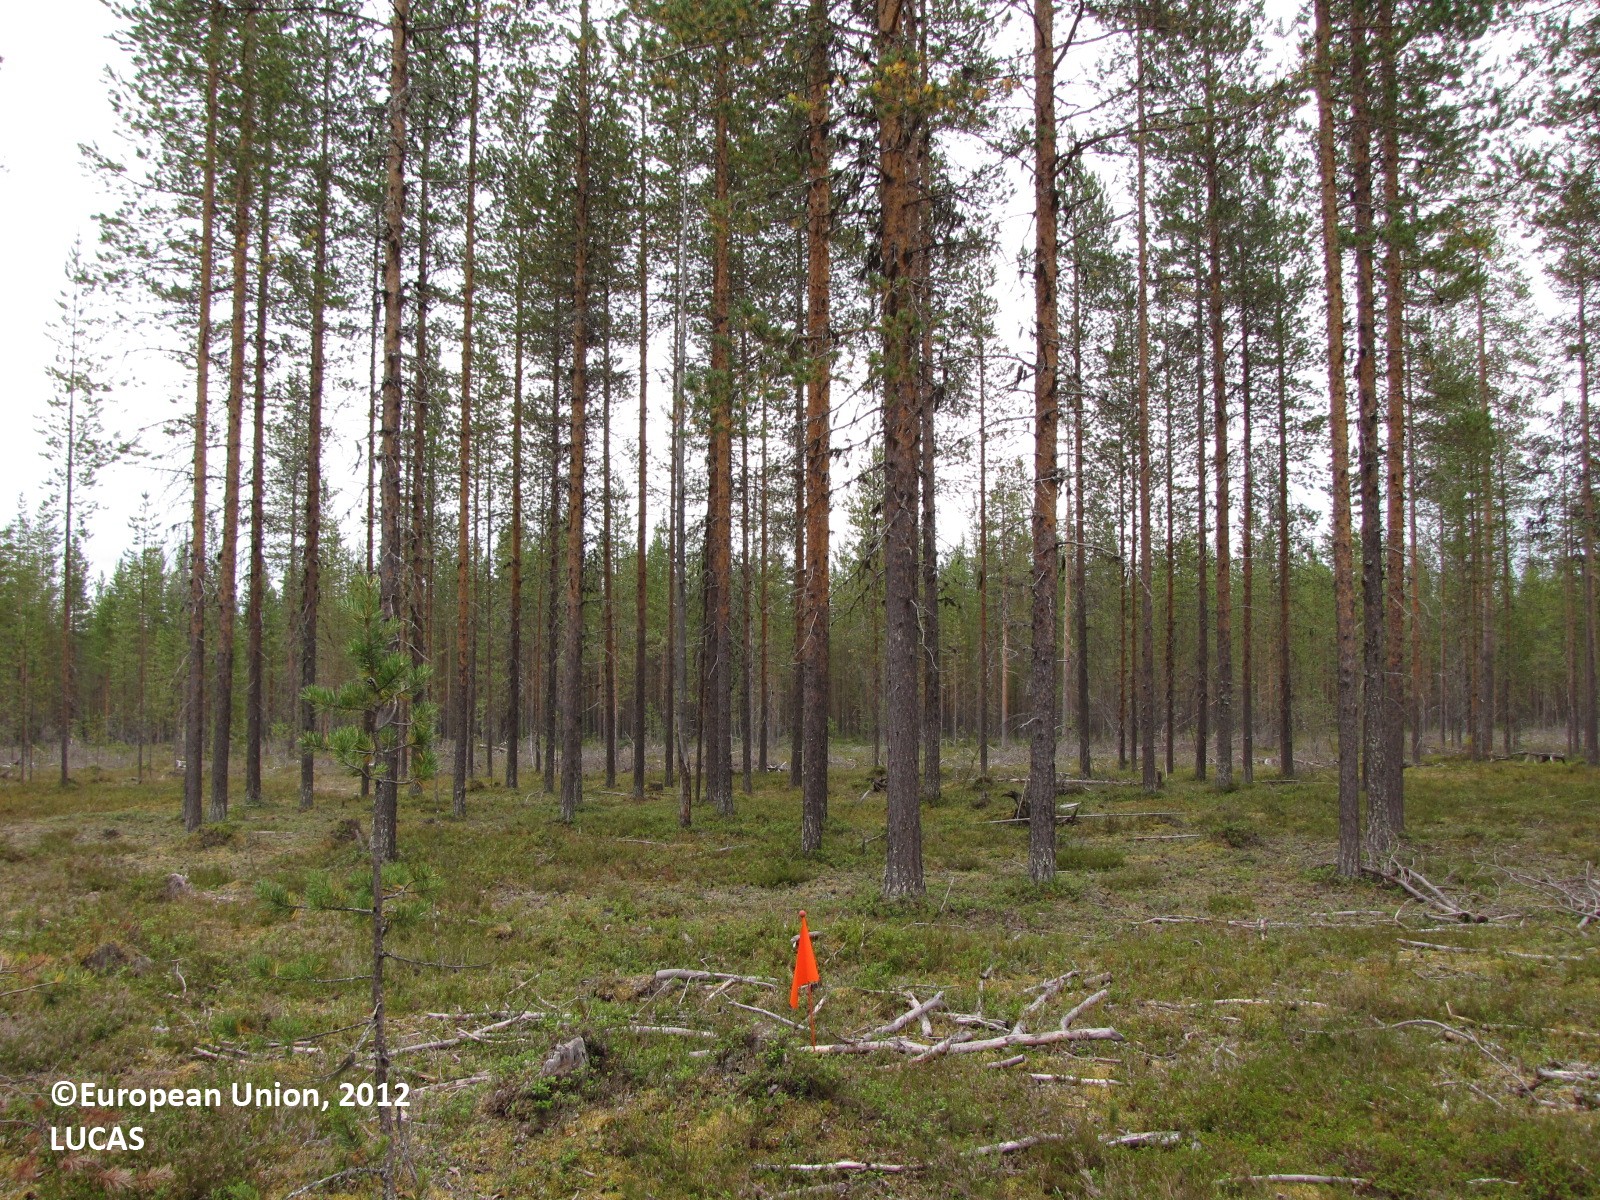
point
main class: Woodland
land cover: Pine dominated coniferous woodland
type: boreal forest
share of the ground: 25 - 50 %
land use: Forestry
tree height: > 5 m
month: August
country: FI
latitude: 67.0502
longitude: 25.1480
